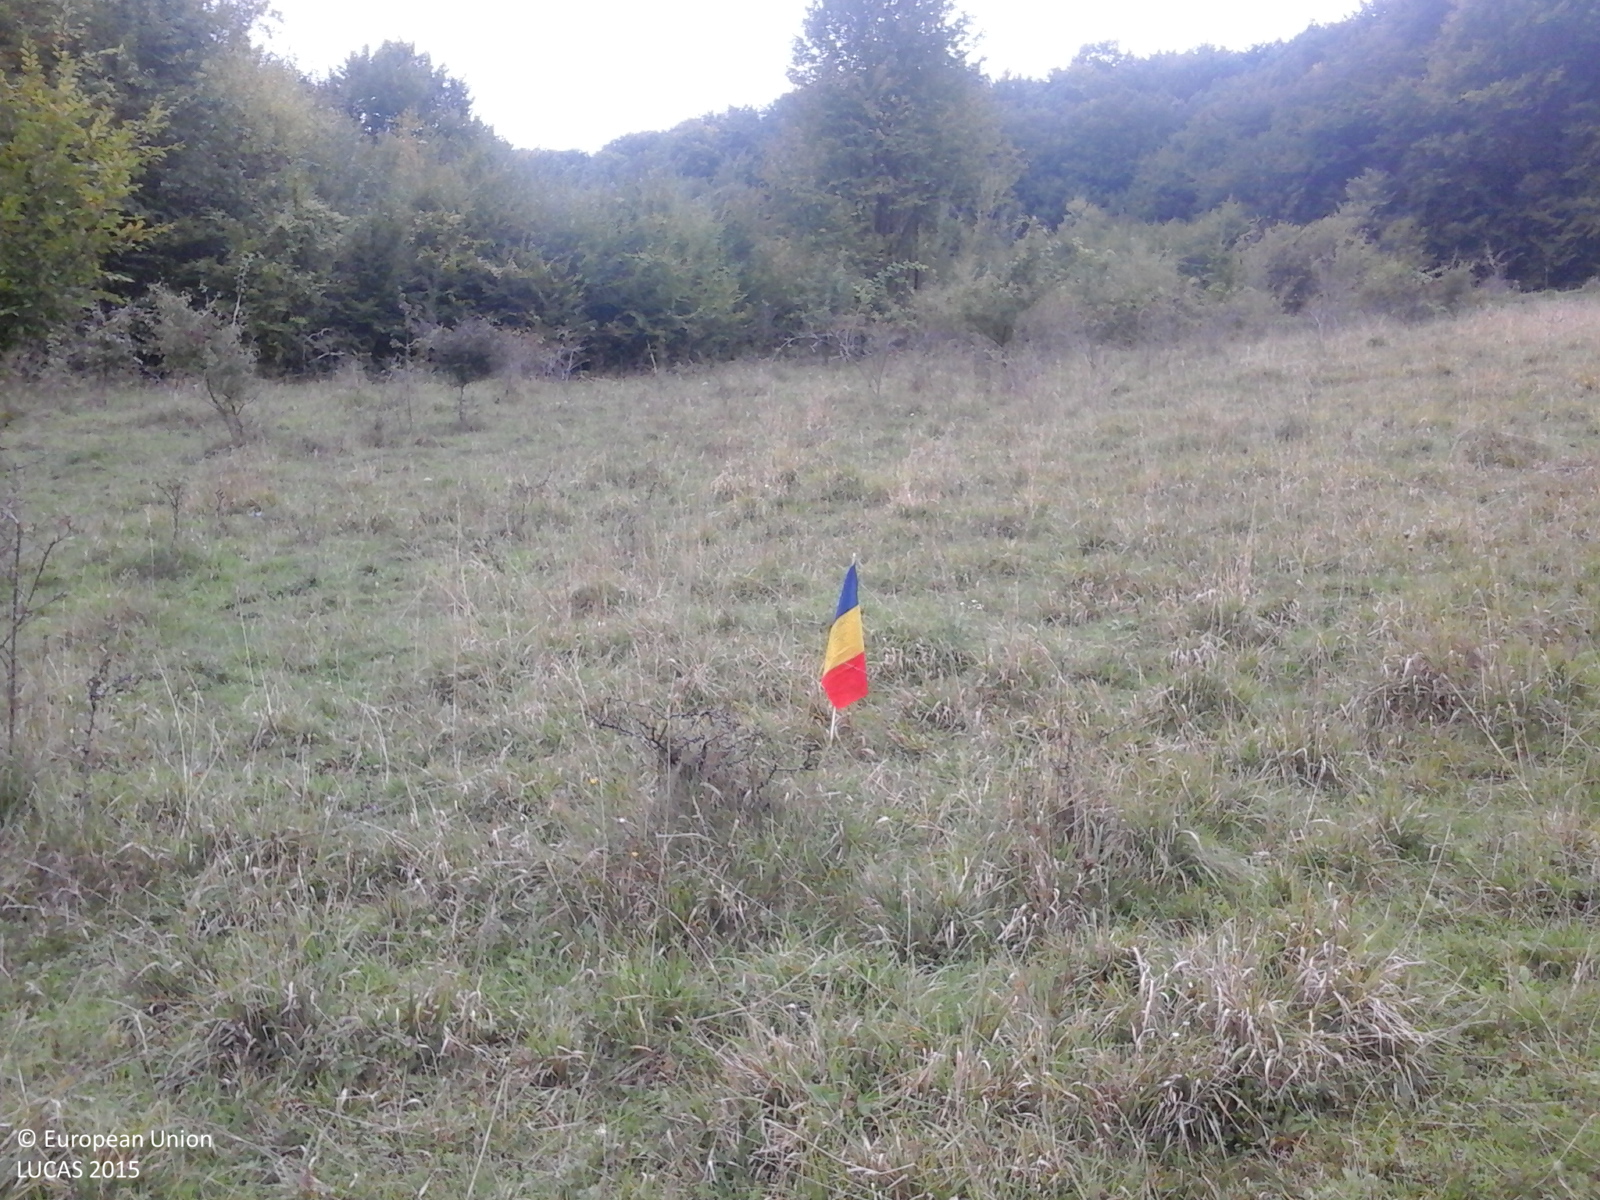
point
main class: Grassland
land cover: Grassland with sparse tree/shrub cover
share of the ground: > 75 %
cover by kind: herbaceous plants 85 %, shrubs 10 %, broadleaved forest trees 5 %
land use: Agriculture (excluding fallow land and kitchen gardens)
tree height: < 5 m
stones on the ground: < 10 %
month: October
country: RO
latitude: 46.0983
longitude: 24.6919
